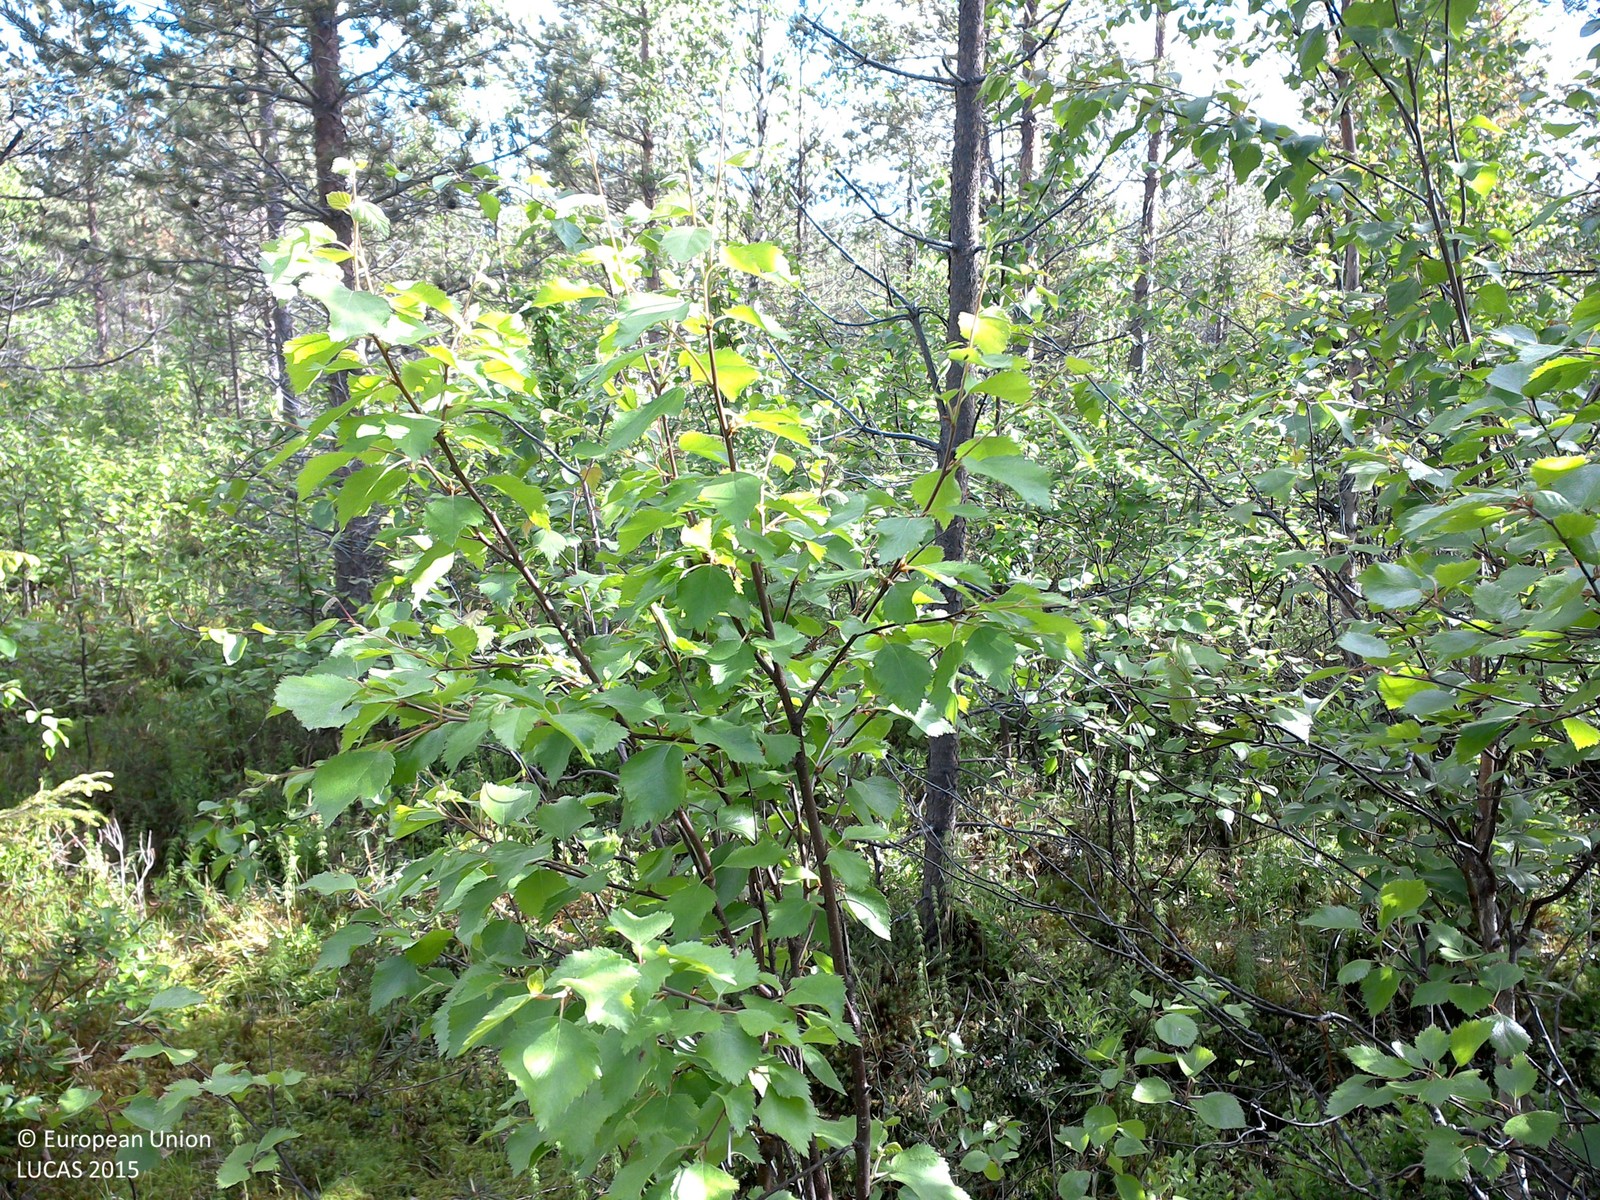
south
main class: Woodland
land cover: Pine dominated mixed woodland
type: boreal forest
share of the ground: 25 - 50 %
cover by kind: shrubs 45 %, coniferous forest trees 30 %, broadleaved forest trees 15 %, herbaceous plants 5 %
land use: Forestry
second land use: Amenities, museums, leisure
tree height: > 5 m
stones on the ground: < 10 %
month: June
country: SE
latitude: 66.6418
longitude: 22.9259
